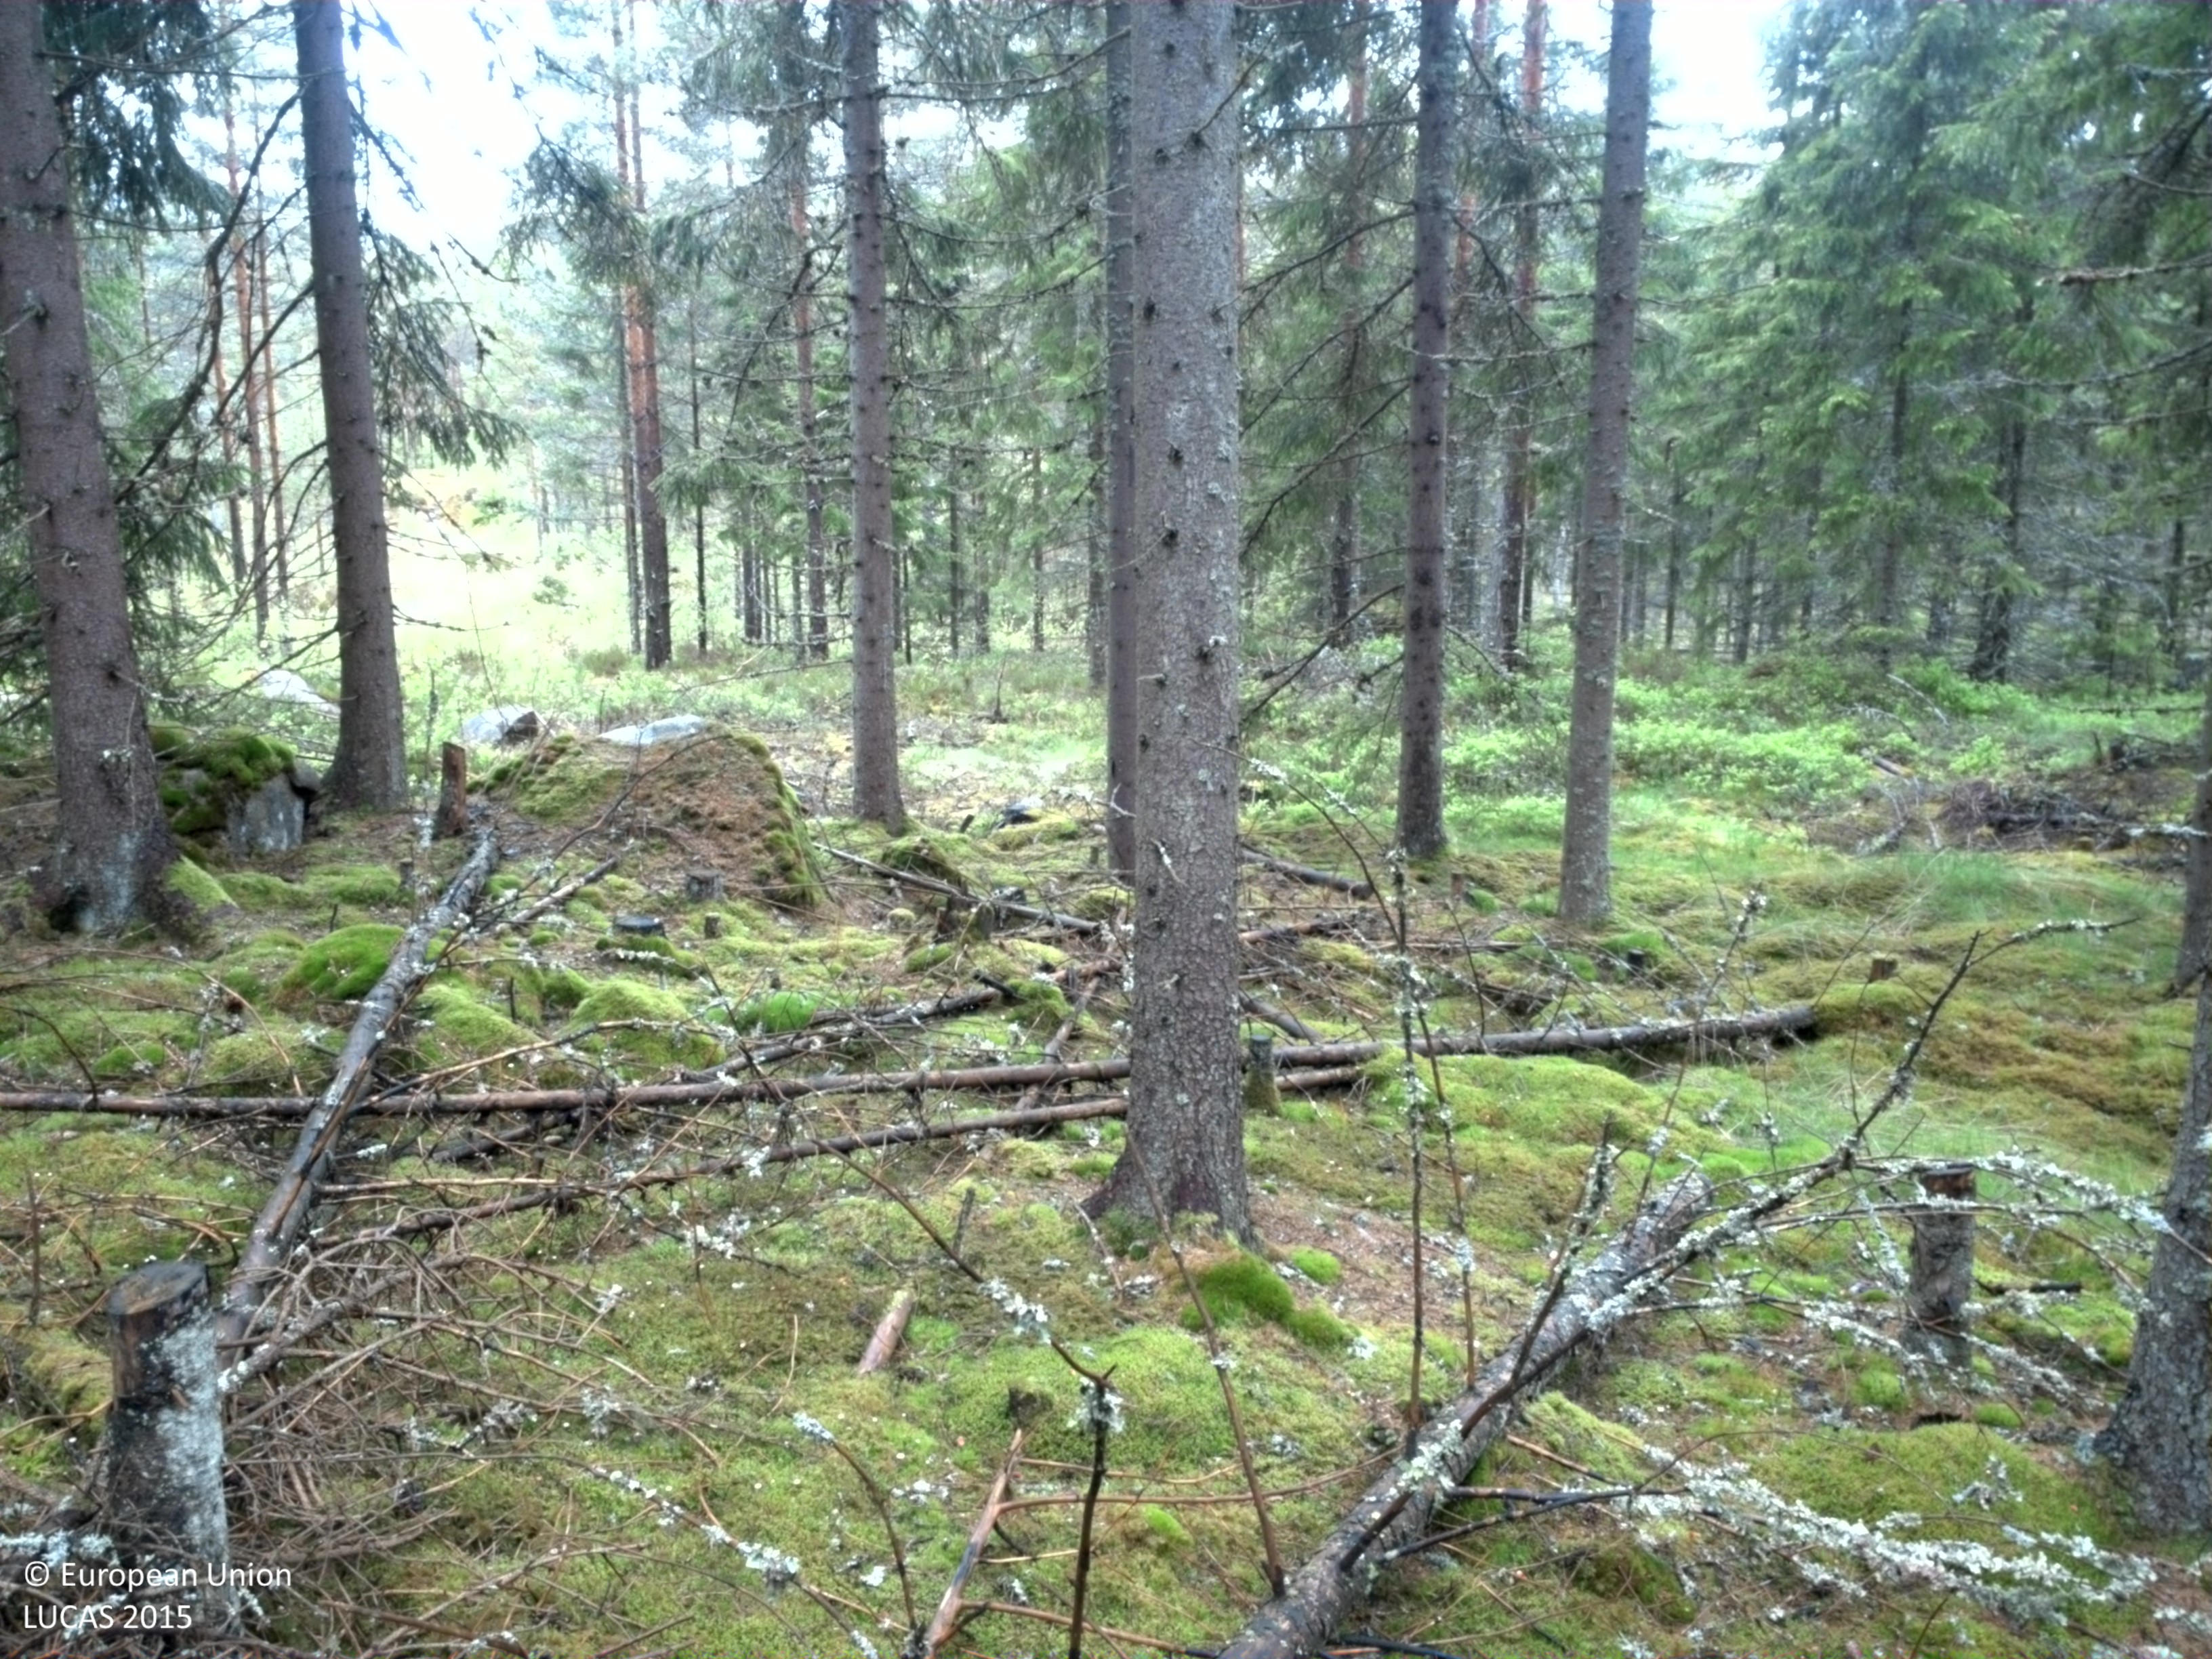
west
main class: Woodland
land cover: Other coniferous woodland
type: boreal forest
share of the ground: 50 - 75 %
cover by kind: coniferous forest trees 70 %, lichens and mosses 15 %, broadleaved forest trees 5 %, shrubs 5 %, herbaceous plants 5 %
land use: Forestry
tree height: > 5 m
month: May
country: SE
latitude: 59.4542
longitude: 14.1015
